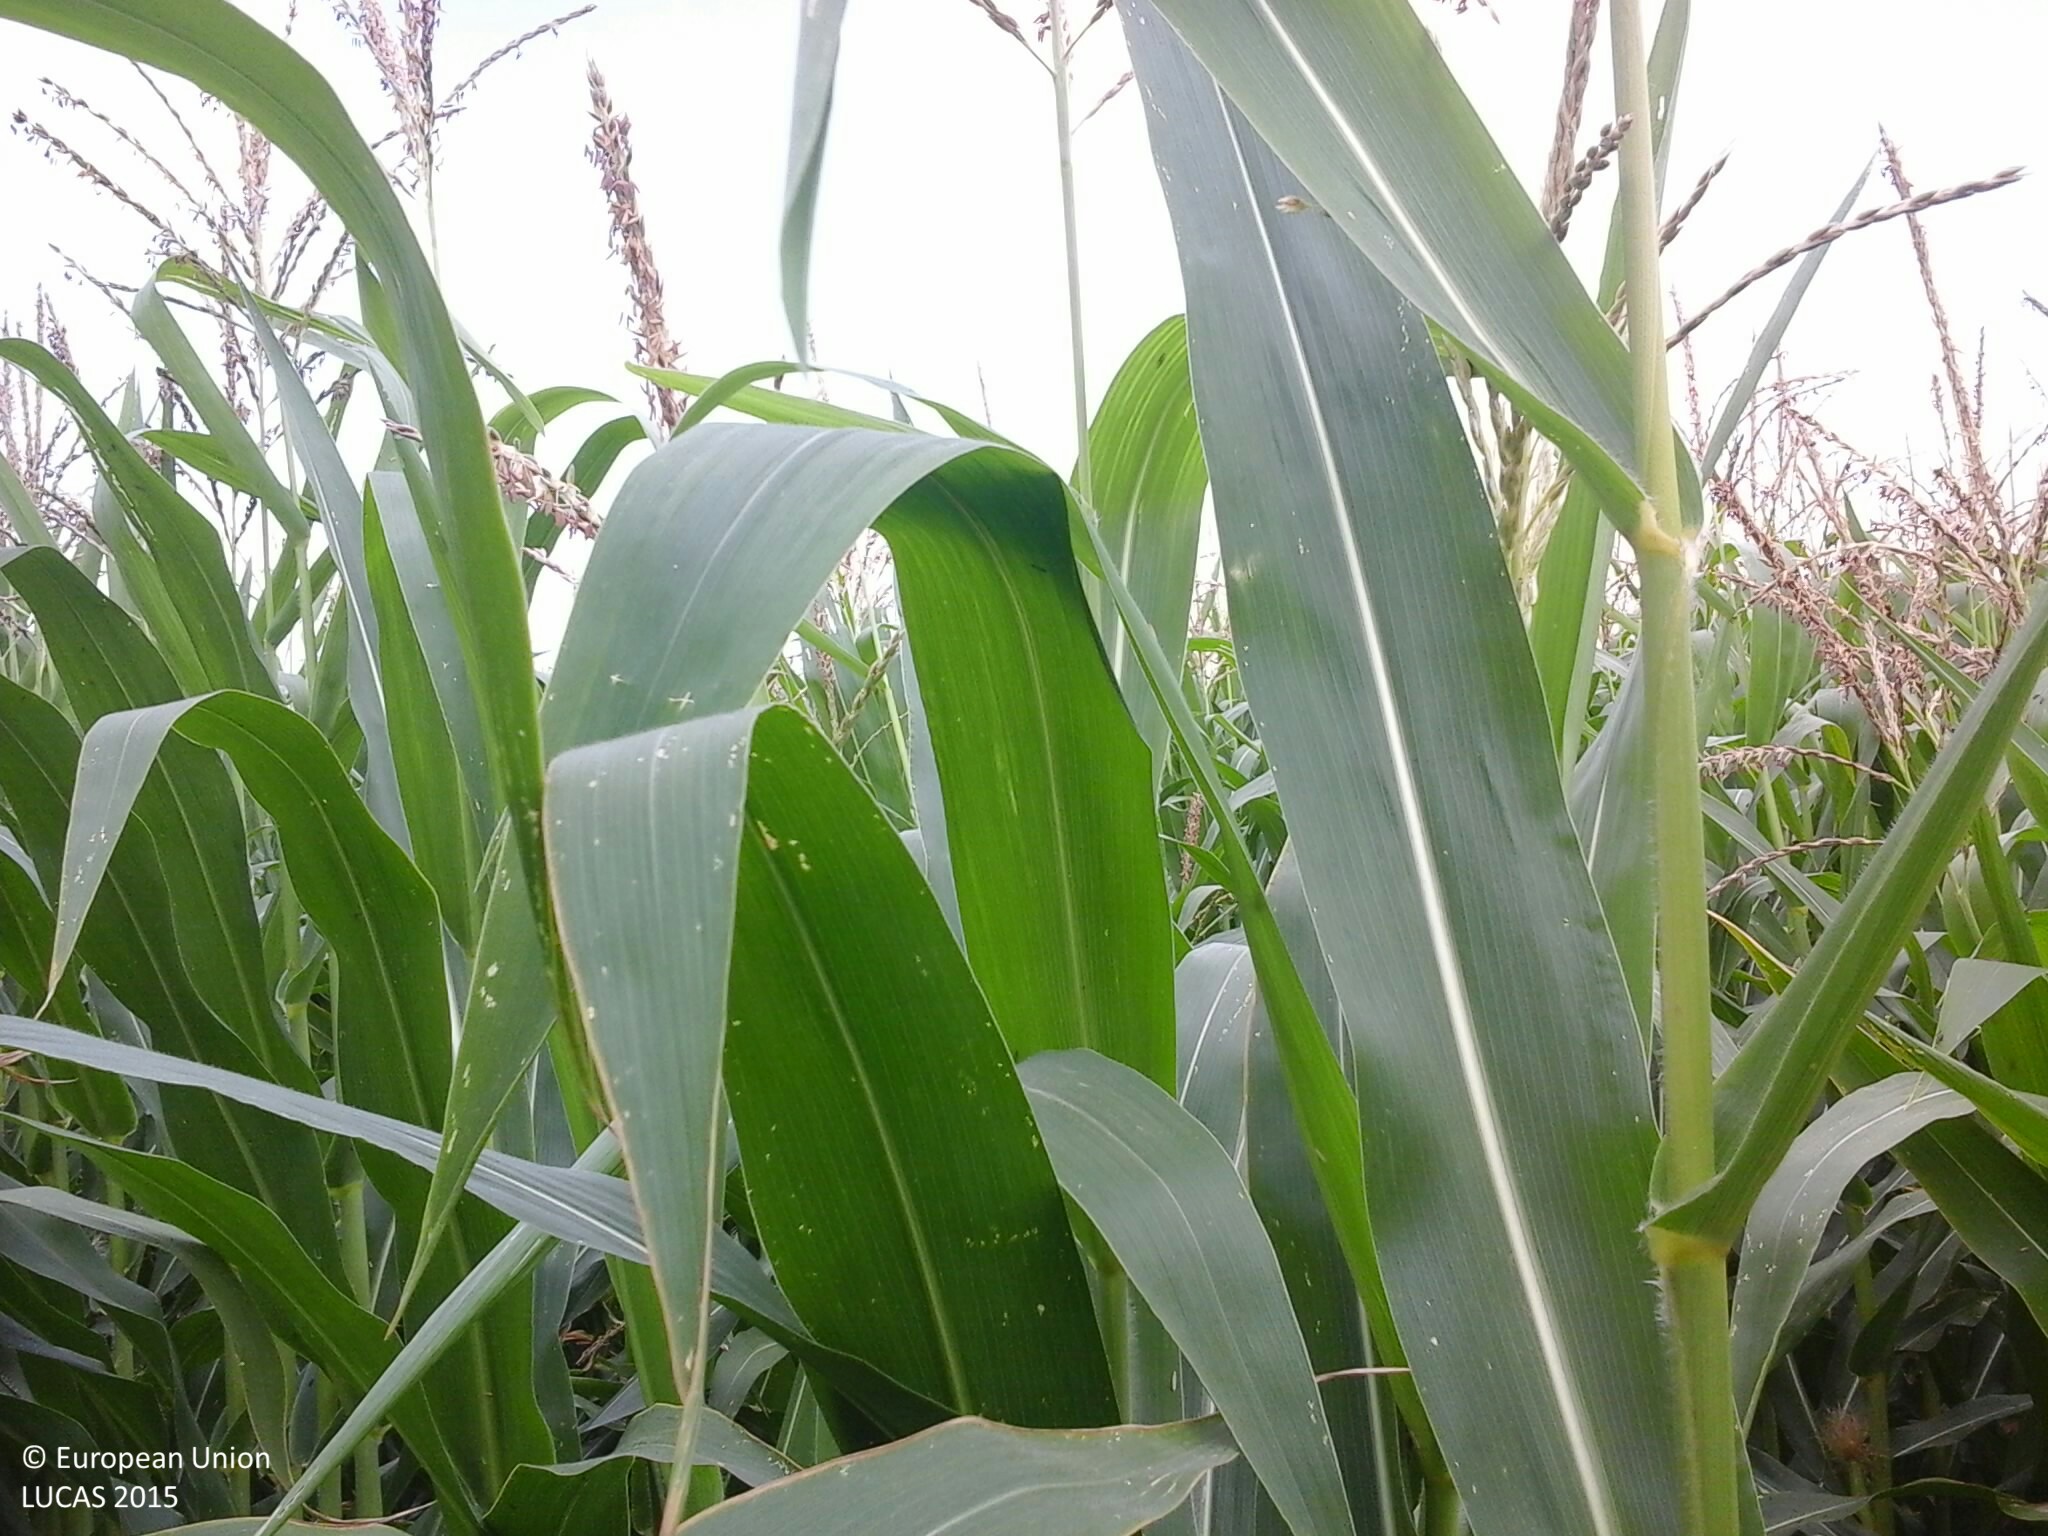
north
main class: Cropland
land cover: Maize
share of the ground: > 75 %
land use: Agriculture (excluding fallow land and kitchen gardens)
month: July
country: HU
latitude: 47.9141
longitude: 22.1362
